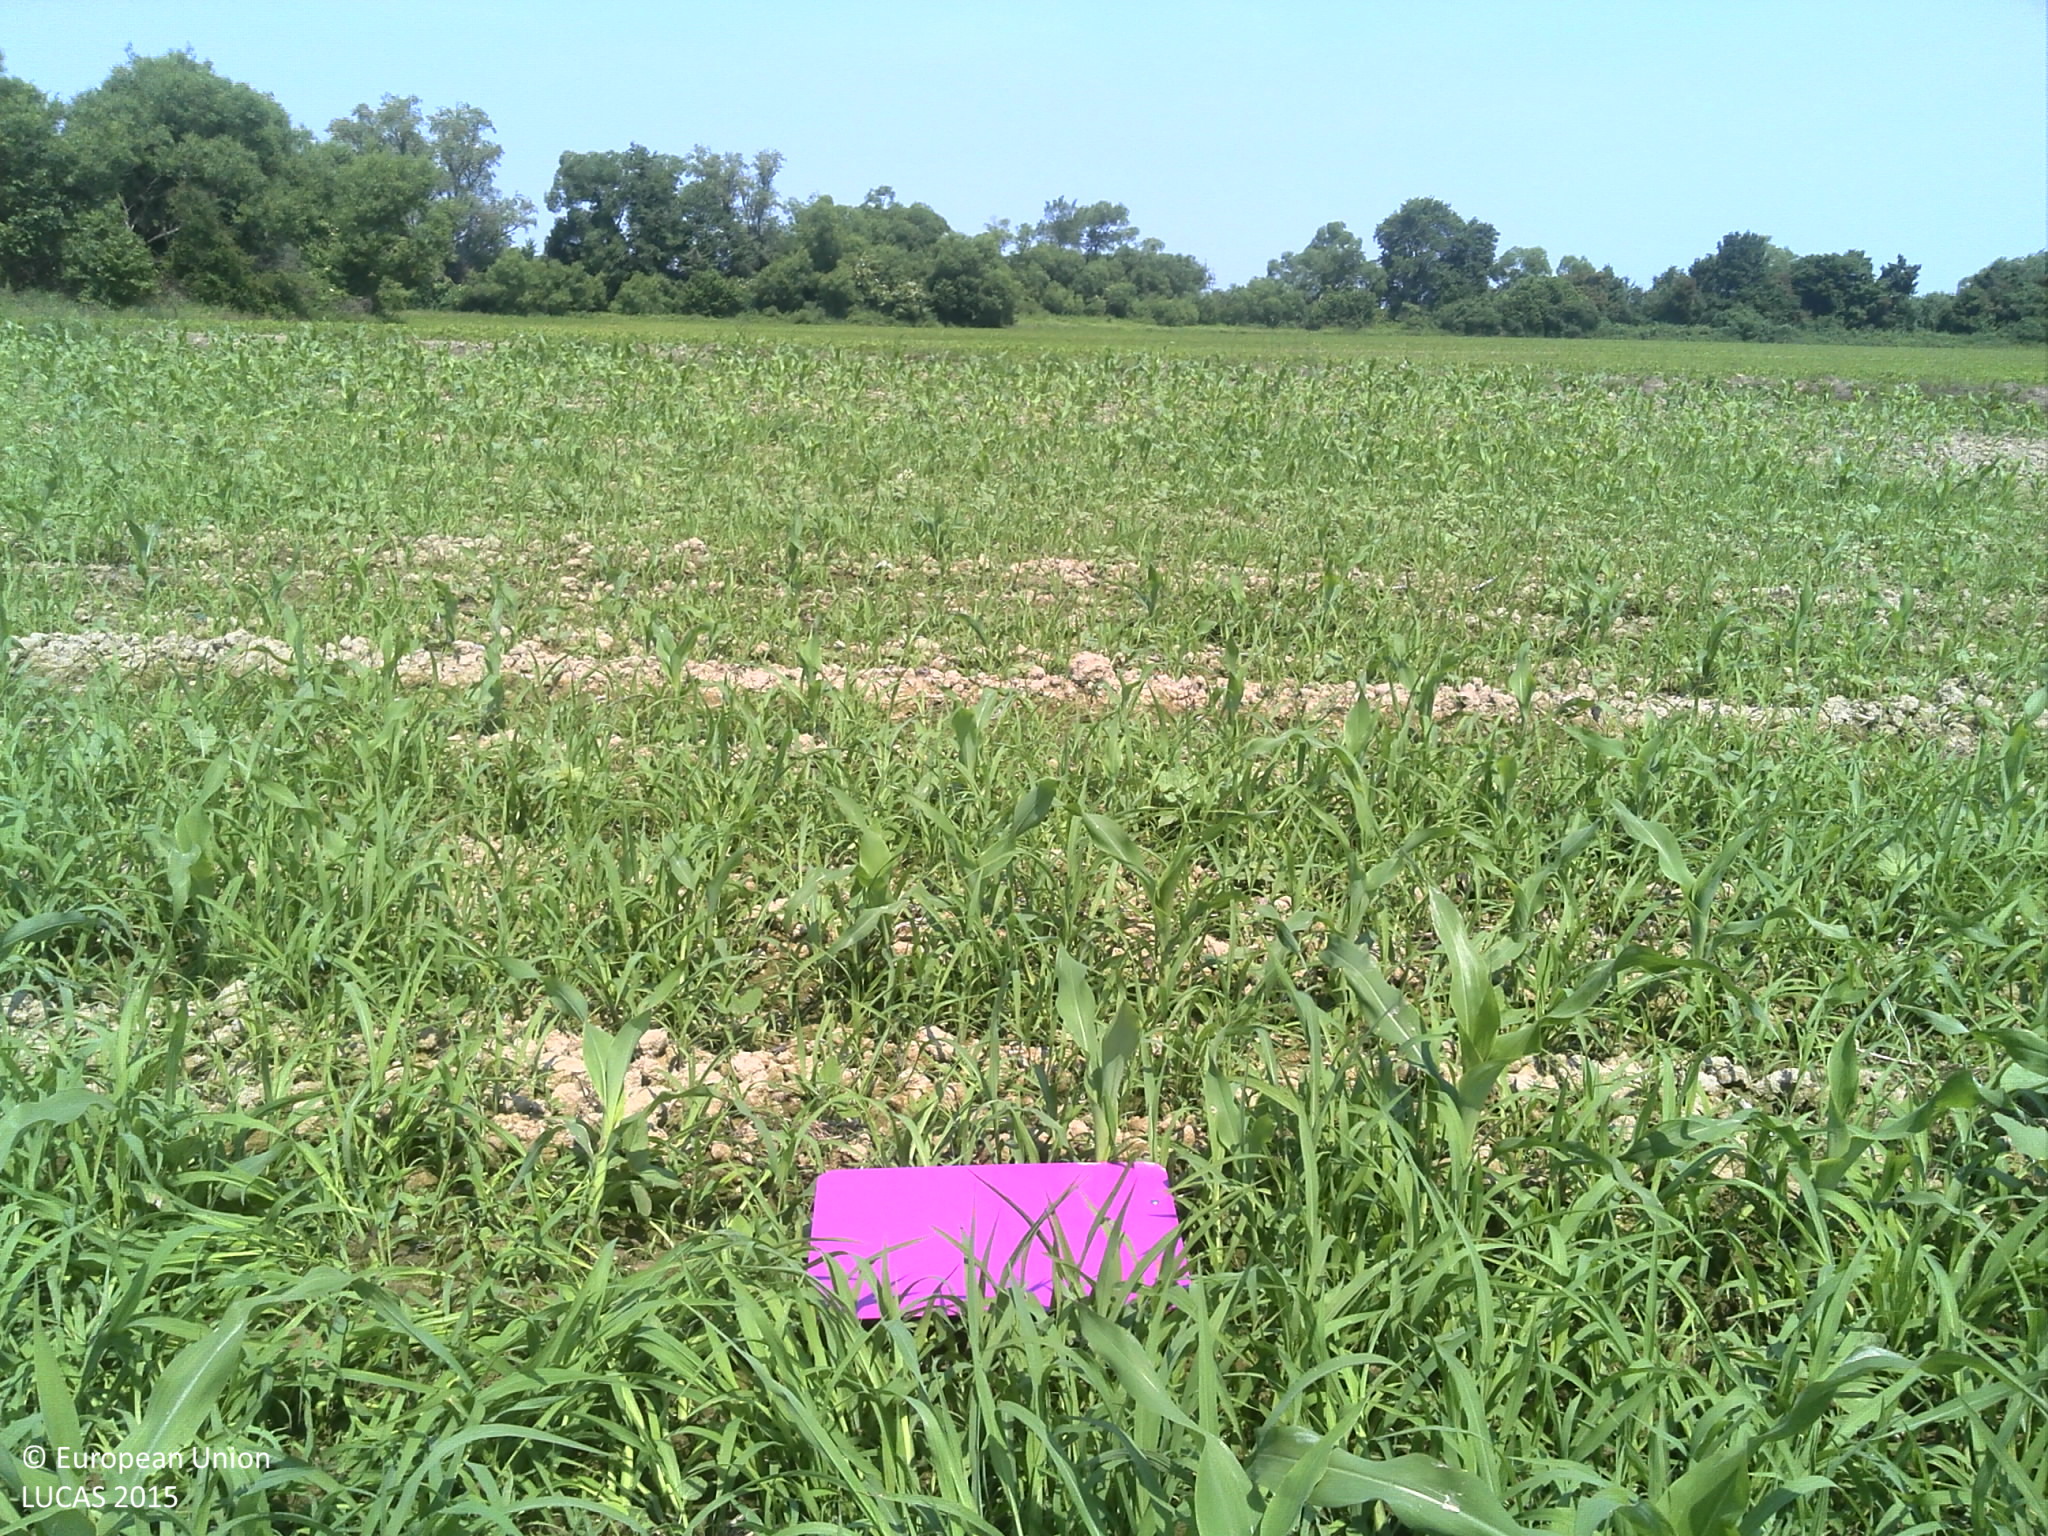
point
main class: Cropland
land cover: Maize
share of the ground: 25 - 50 %
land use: Agriculture (excluding fallow land and kitchen gardens)
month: June
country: HR
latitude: 45.6749
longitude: 17.9506
